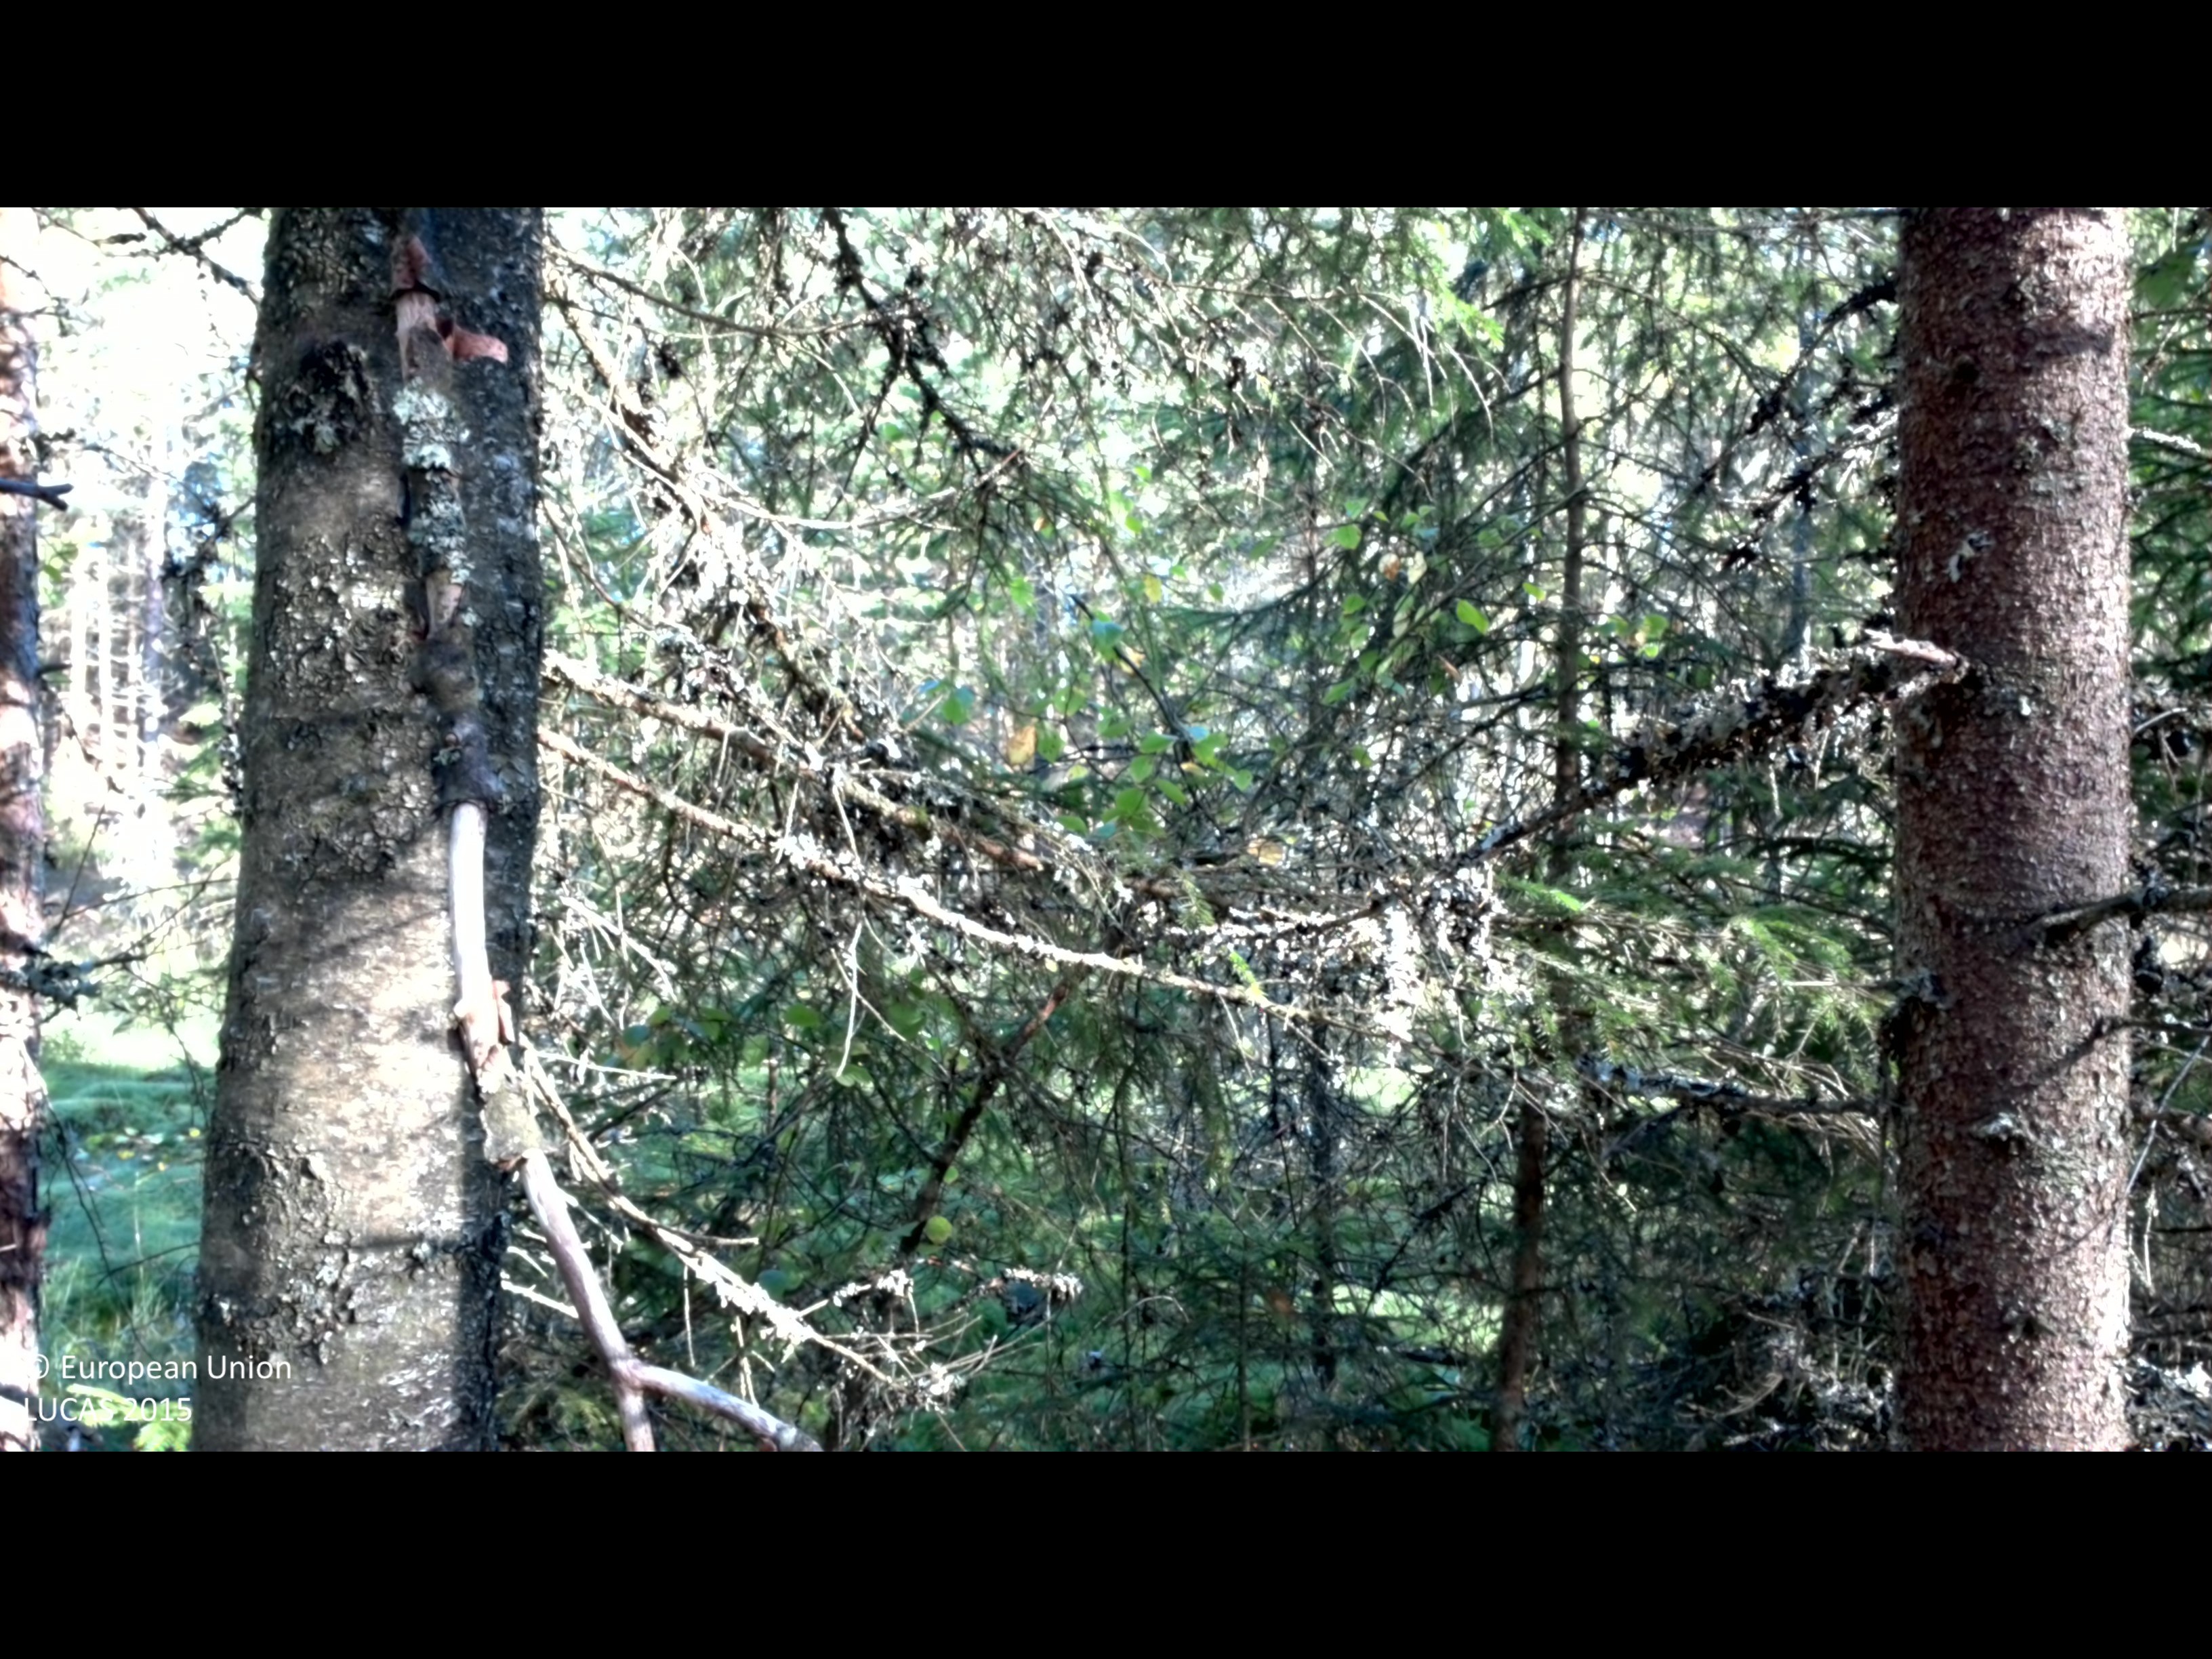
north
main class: Woodland
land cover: Spruce dominated mixed woodland
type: boreal forest
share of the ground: 50 - 75 %
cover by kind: coniferous forest trees 45 %, broadleaved forest trees 30 %, shrubs 10 %, lichens and mosses 10 %, herbaceous plants 5 %
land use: Forestry
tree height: > 5 m
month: September
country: SE
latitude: 57.0832
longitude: 13.2137
